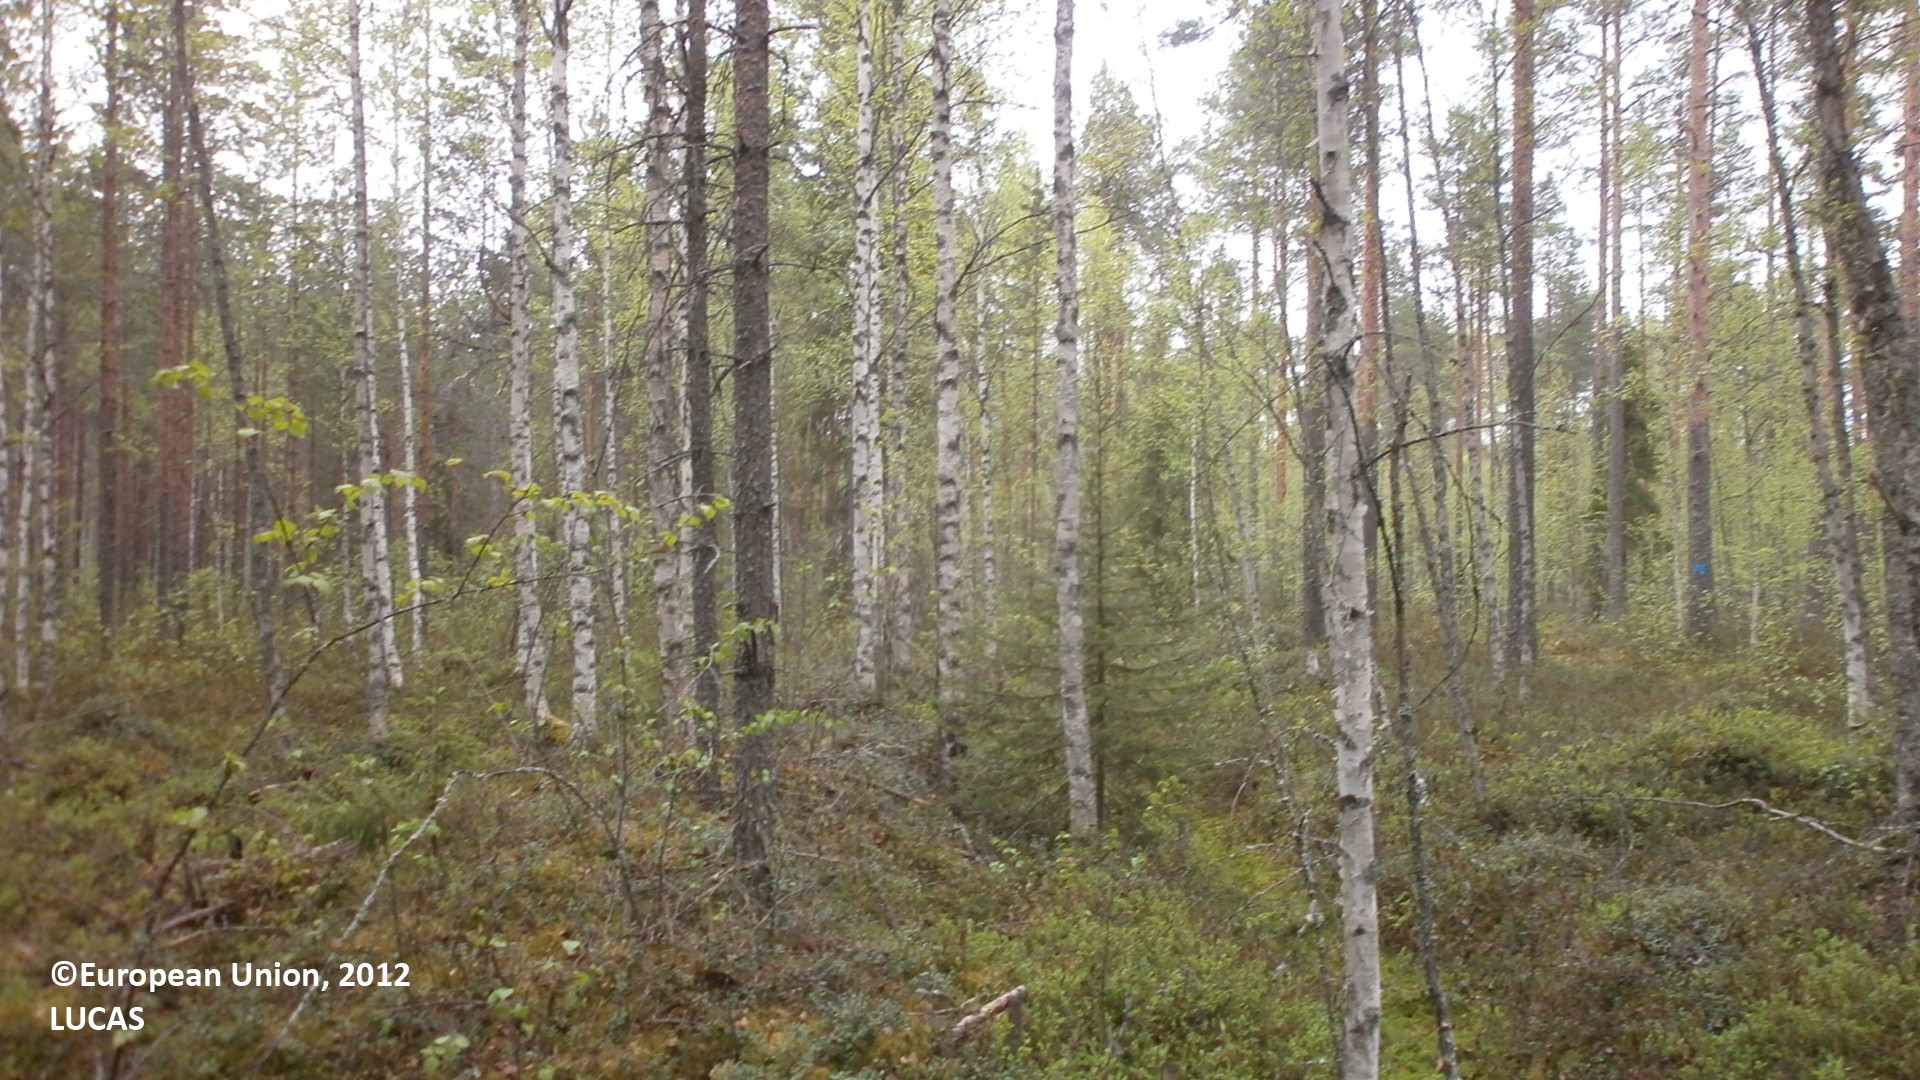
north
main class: Woodland
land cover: Pine dominated mixed woodland
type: hemiboreal forest and nemoral coniferous forest and mixed broadleaved-coniferous forest
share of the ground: 50 - 75 %
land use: Forestry
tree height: > 5 m
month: June
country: FI
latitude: 64.2953
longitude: 25.8678
